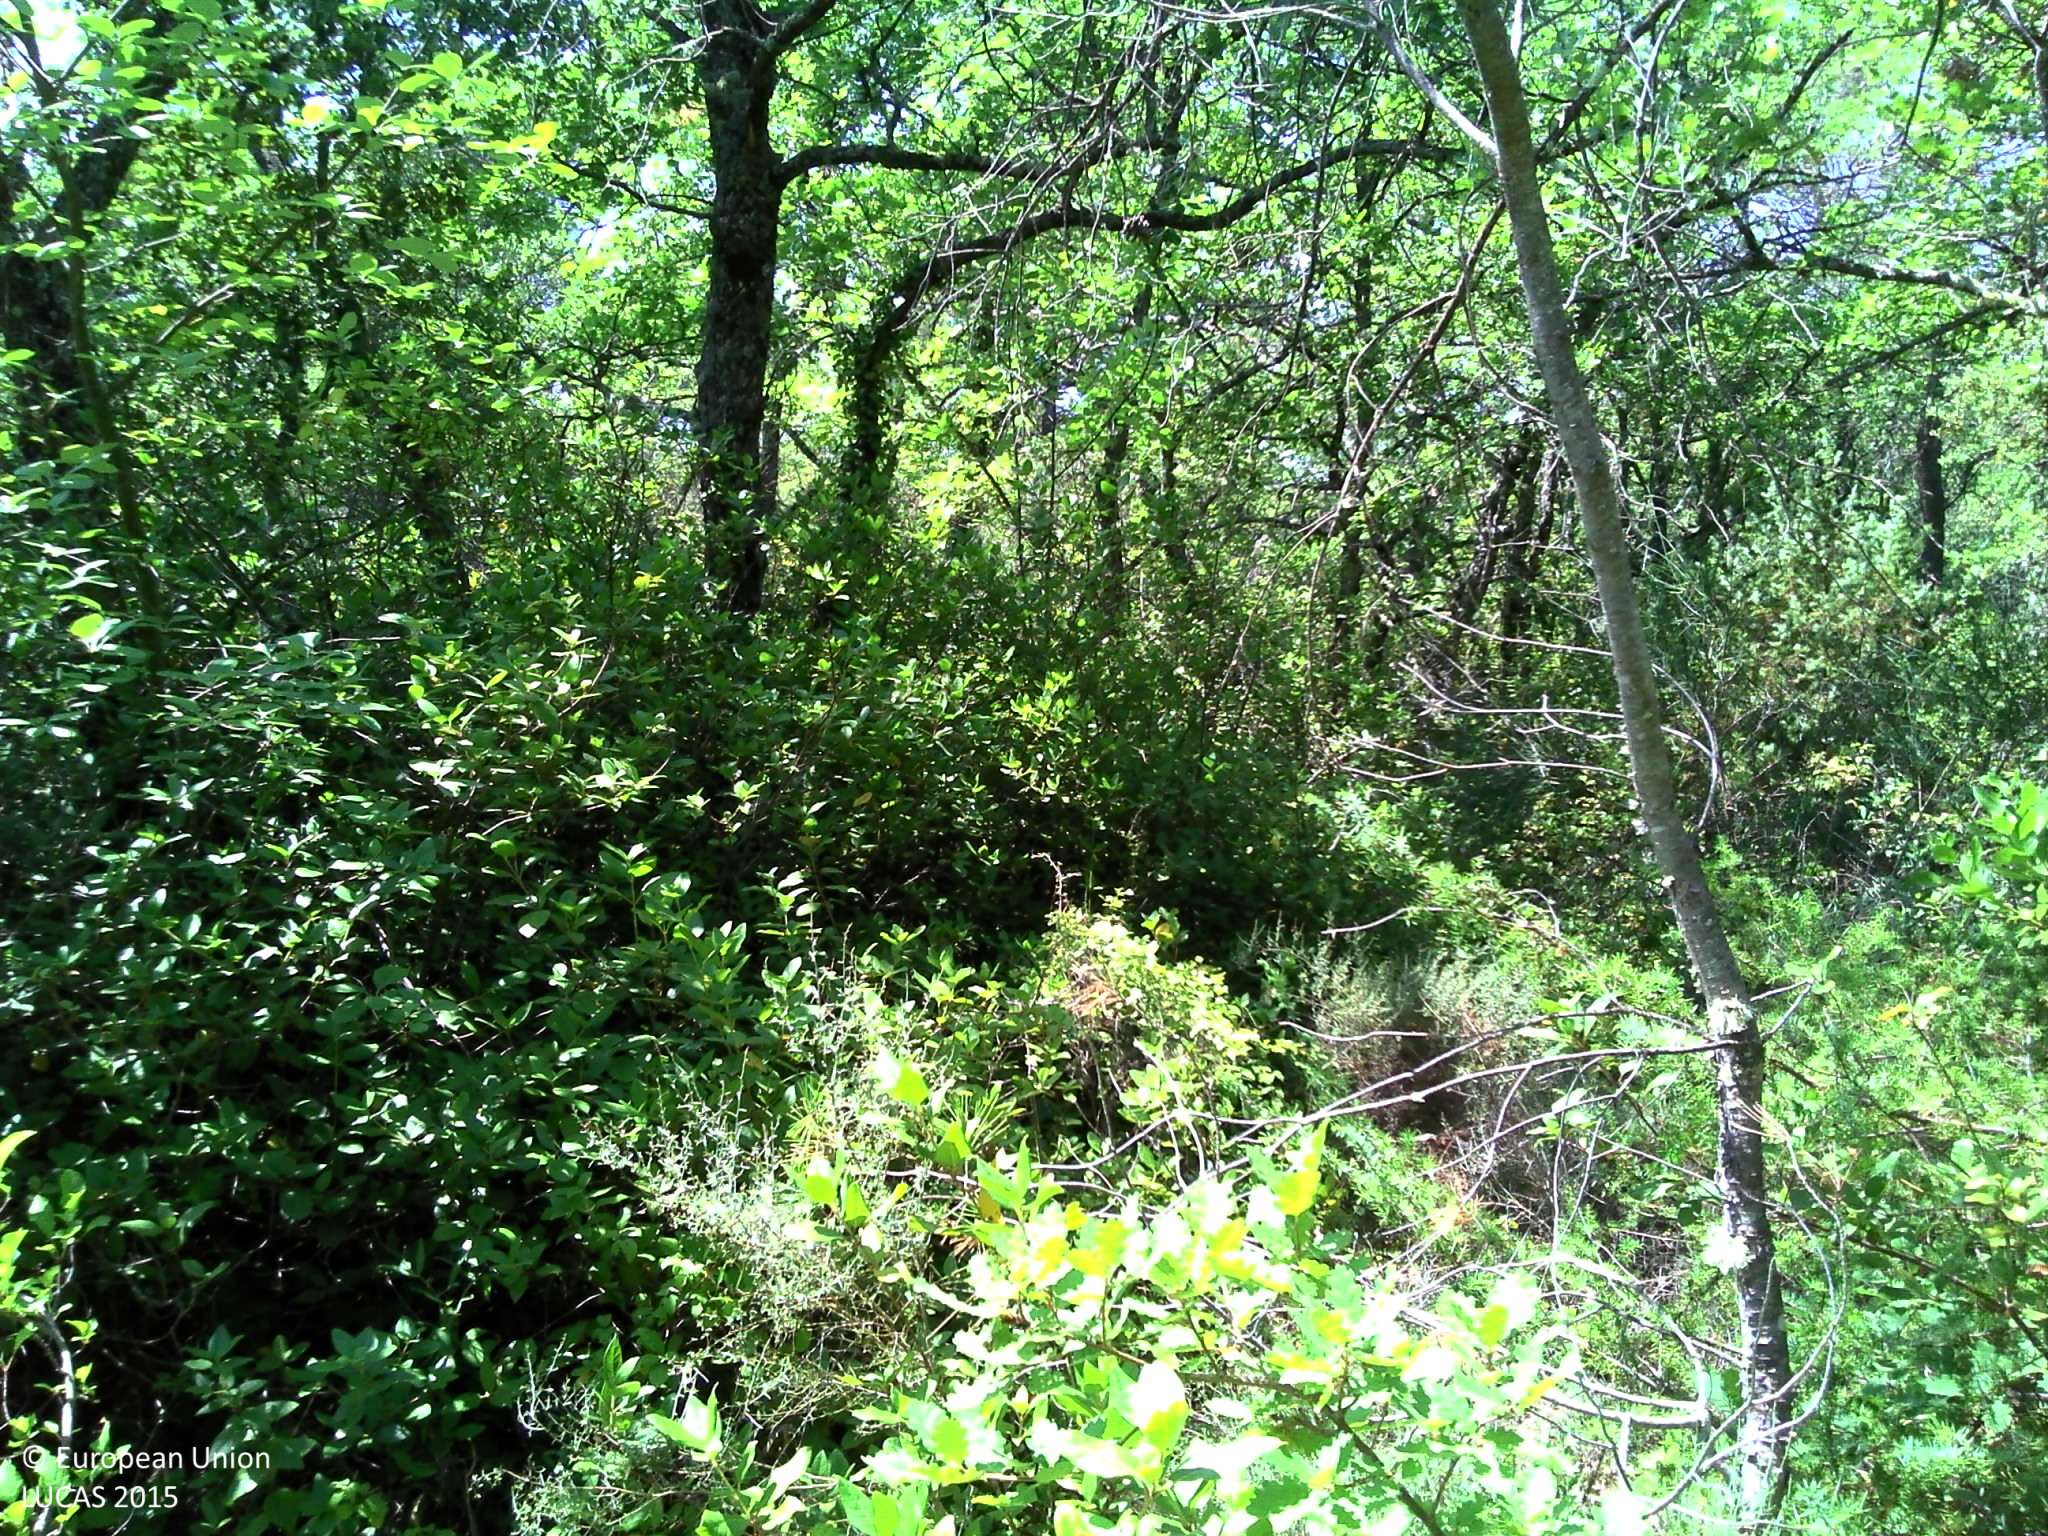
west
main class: Woodland
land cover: Pine dominated mixed woodland
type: coniferous forest of the mediterranean region
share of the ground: 50 - 75 %
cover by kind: coniferous forest trees 40 %, broadleaved forest trees 30 %, shrubs 20 %, herbaceous plants 5 %, lichens and mosses 5 %
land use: Forestry
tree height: > 5 m
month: July
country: FR
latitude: 44.0218
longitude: 5.1804
